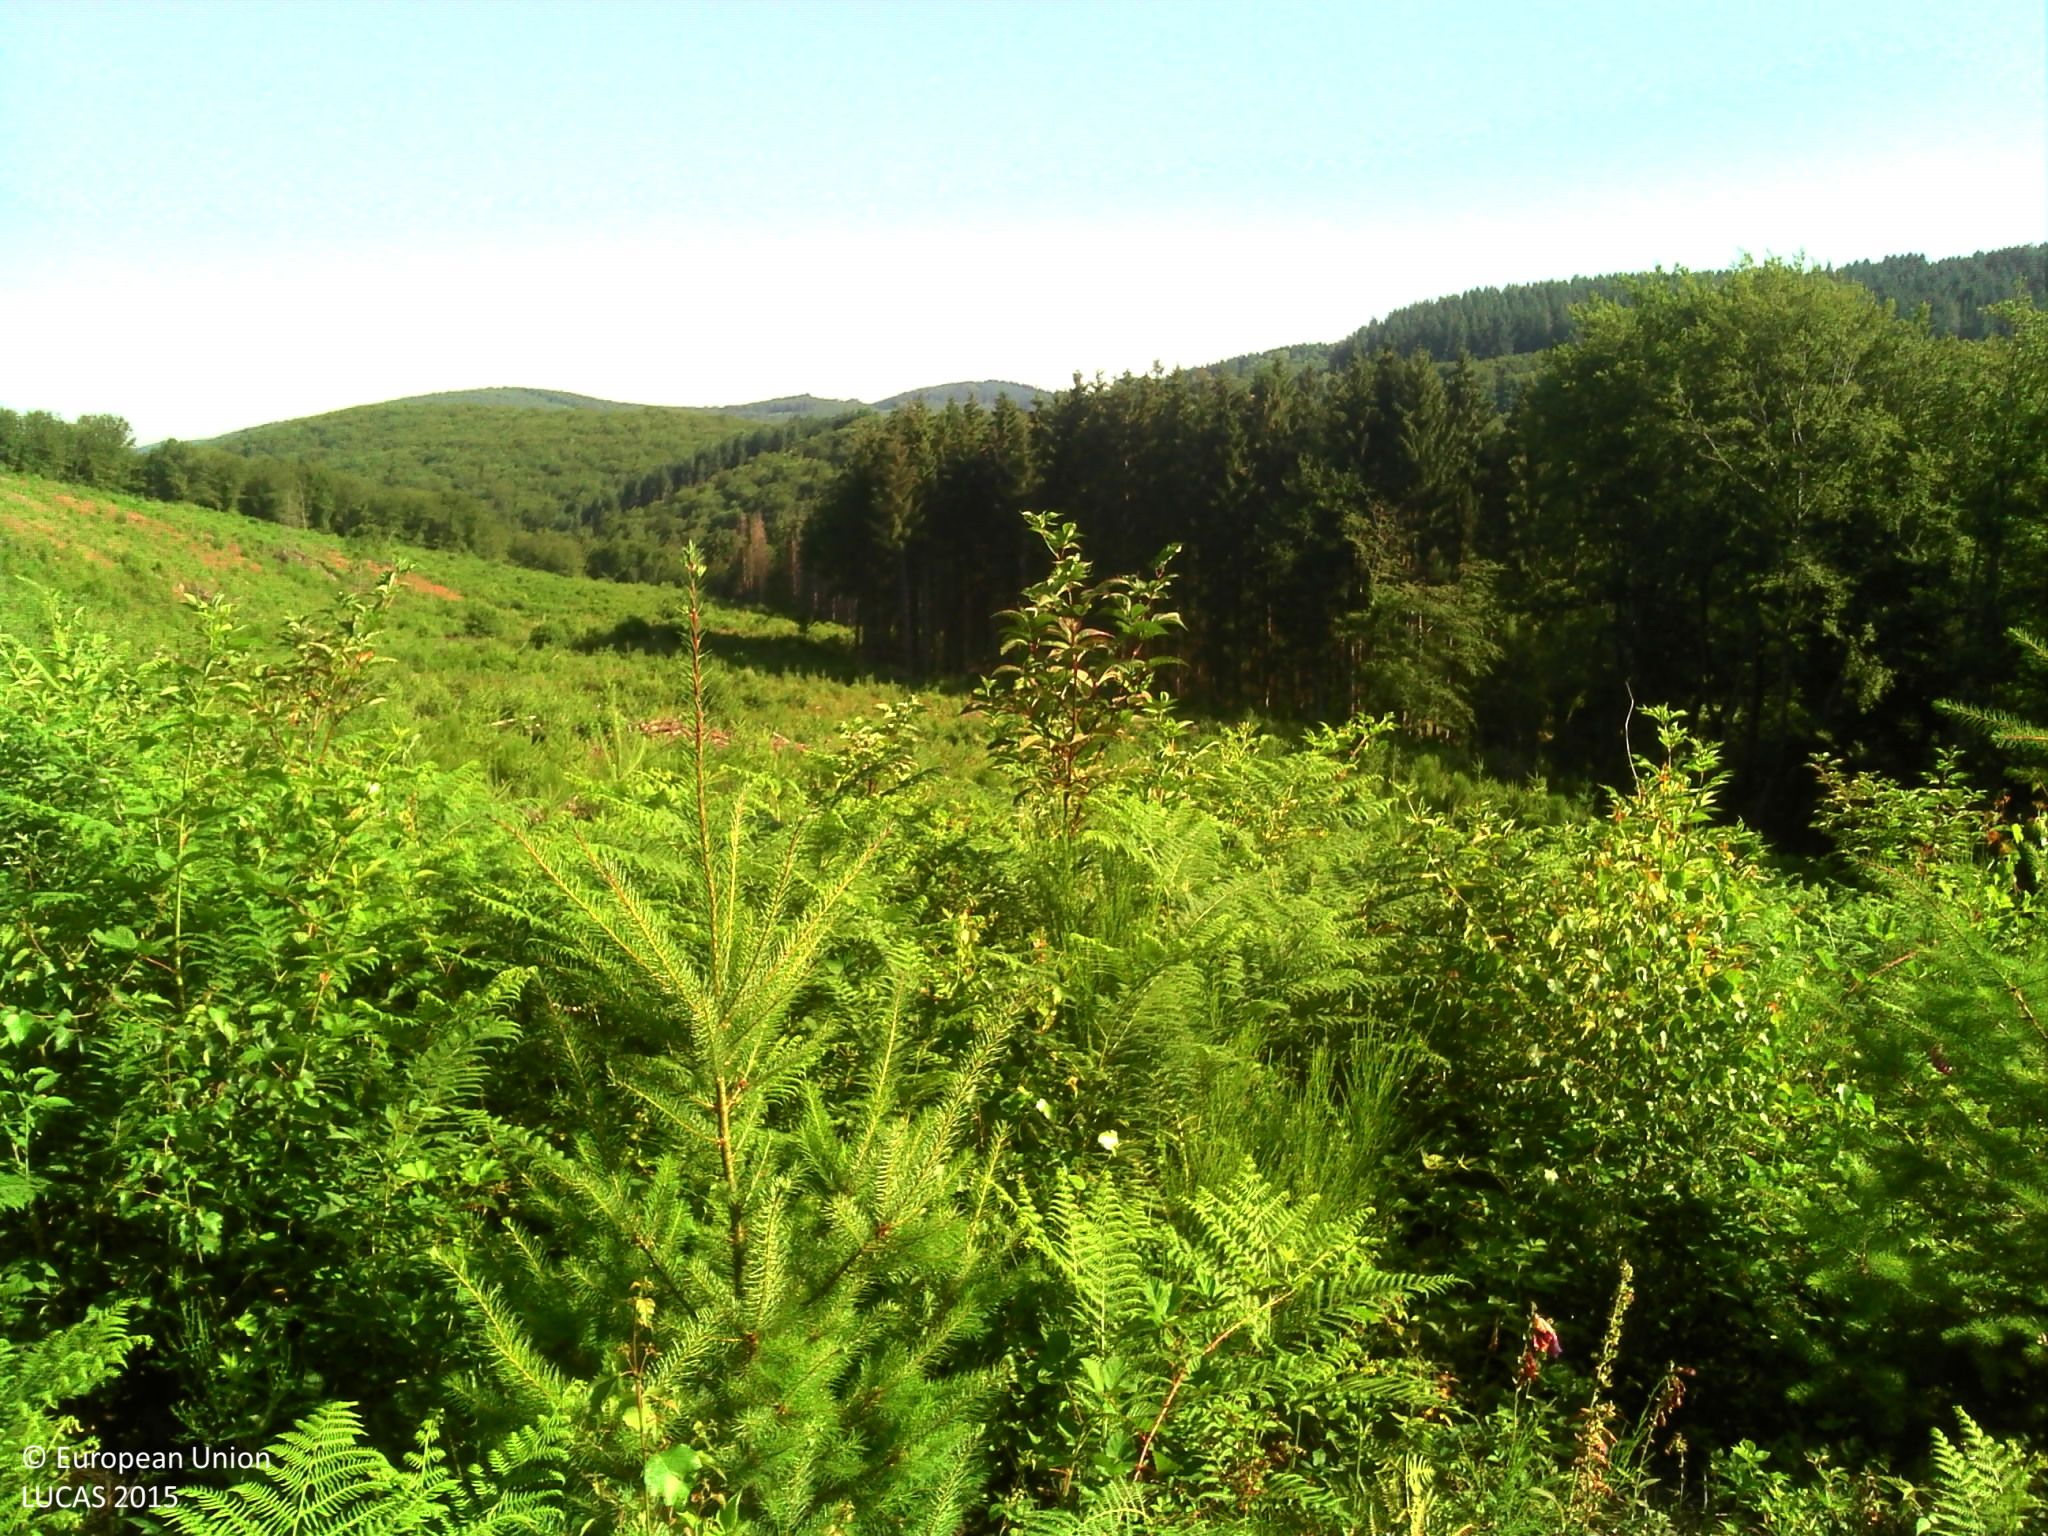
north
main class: Woodland
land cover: Spruce dominated coniferous woodland
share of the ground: 50 - 75 %
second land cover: Spontaneously vegetated surfaces
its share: 25 - 50 %
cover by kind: coniferous forest trees 60 %, broadleaved forest trees 20 %, shrubs 10 %, herbaceous plants 10 %
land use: Forestry
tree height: < 5 m
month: July
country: FR
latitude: 47.1038
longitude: 4.0034
